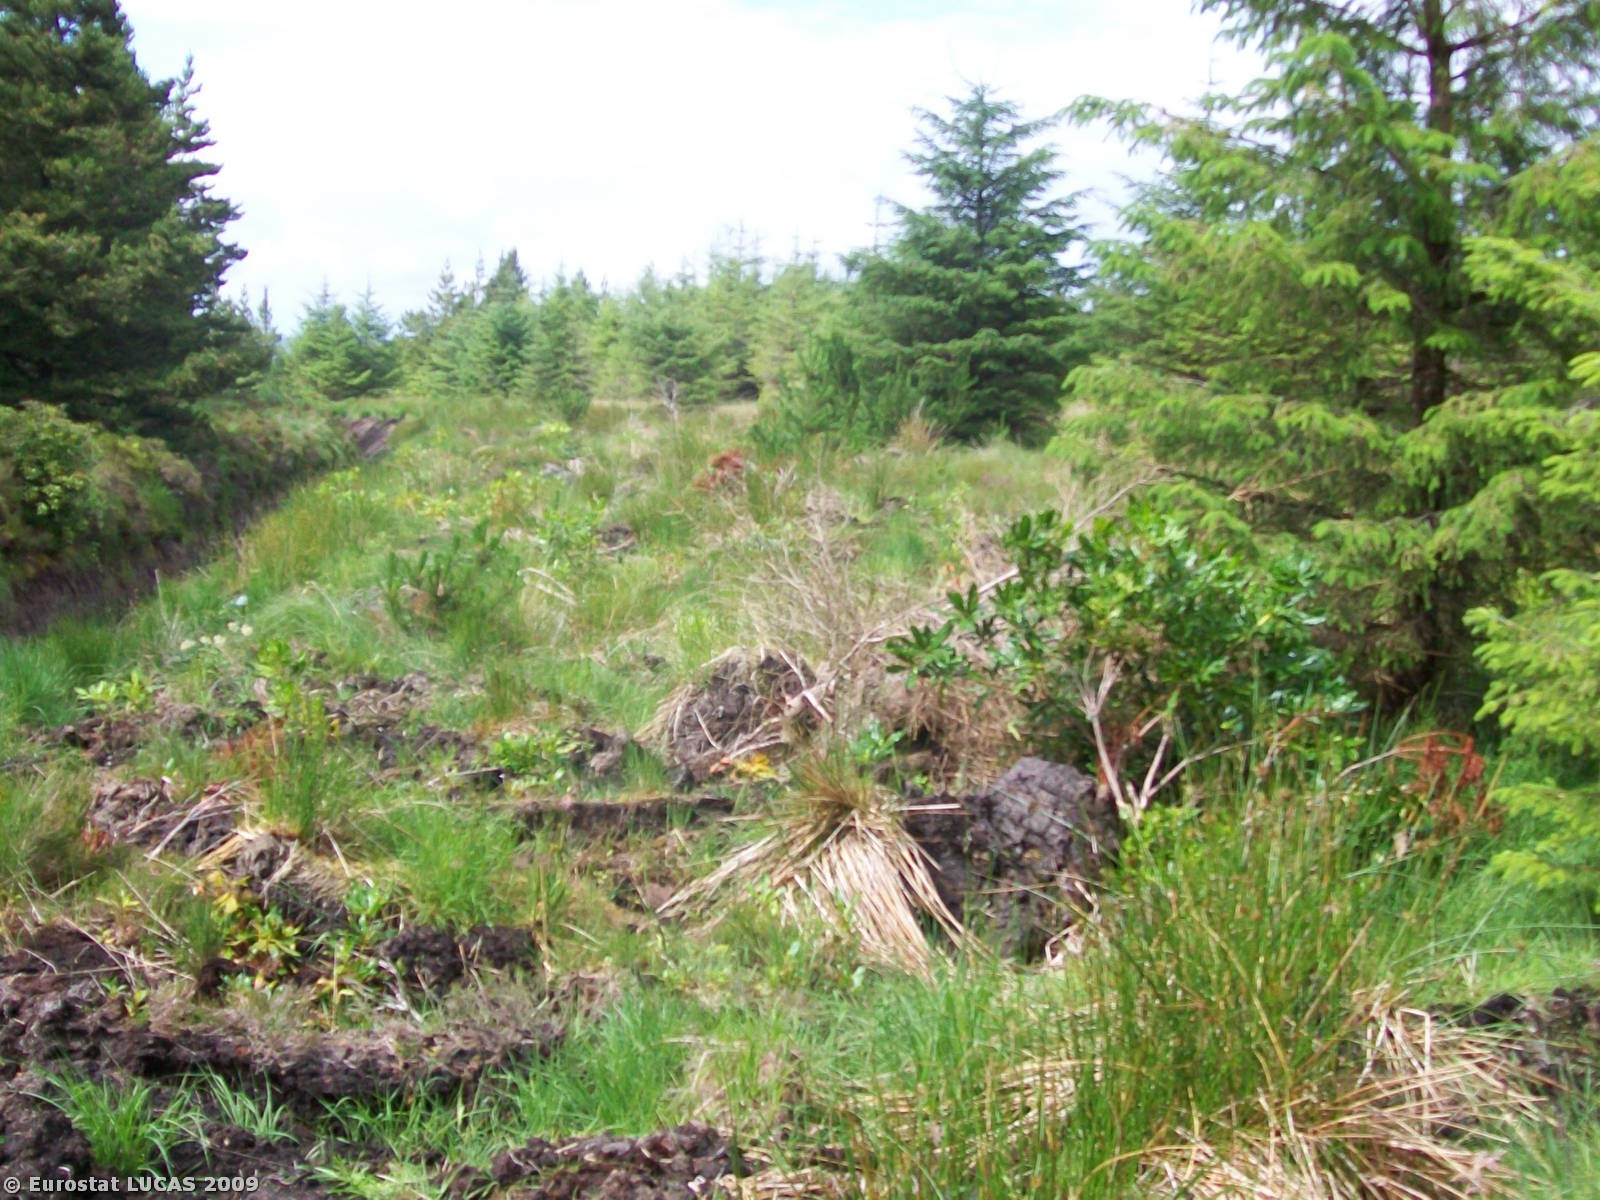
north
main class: Woodland
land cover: Coniferous woodland
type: plantations and self-sown exotic forest
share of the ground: > 75 %
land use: Forestry
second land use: Nature reserves
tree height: > 5 m
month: July
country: IE
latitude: 54.0814
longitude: -9.7942
